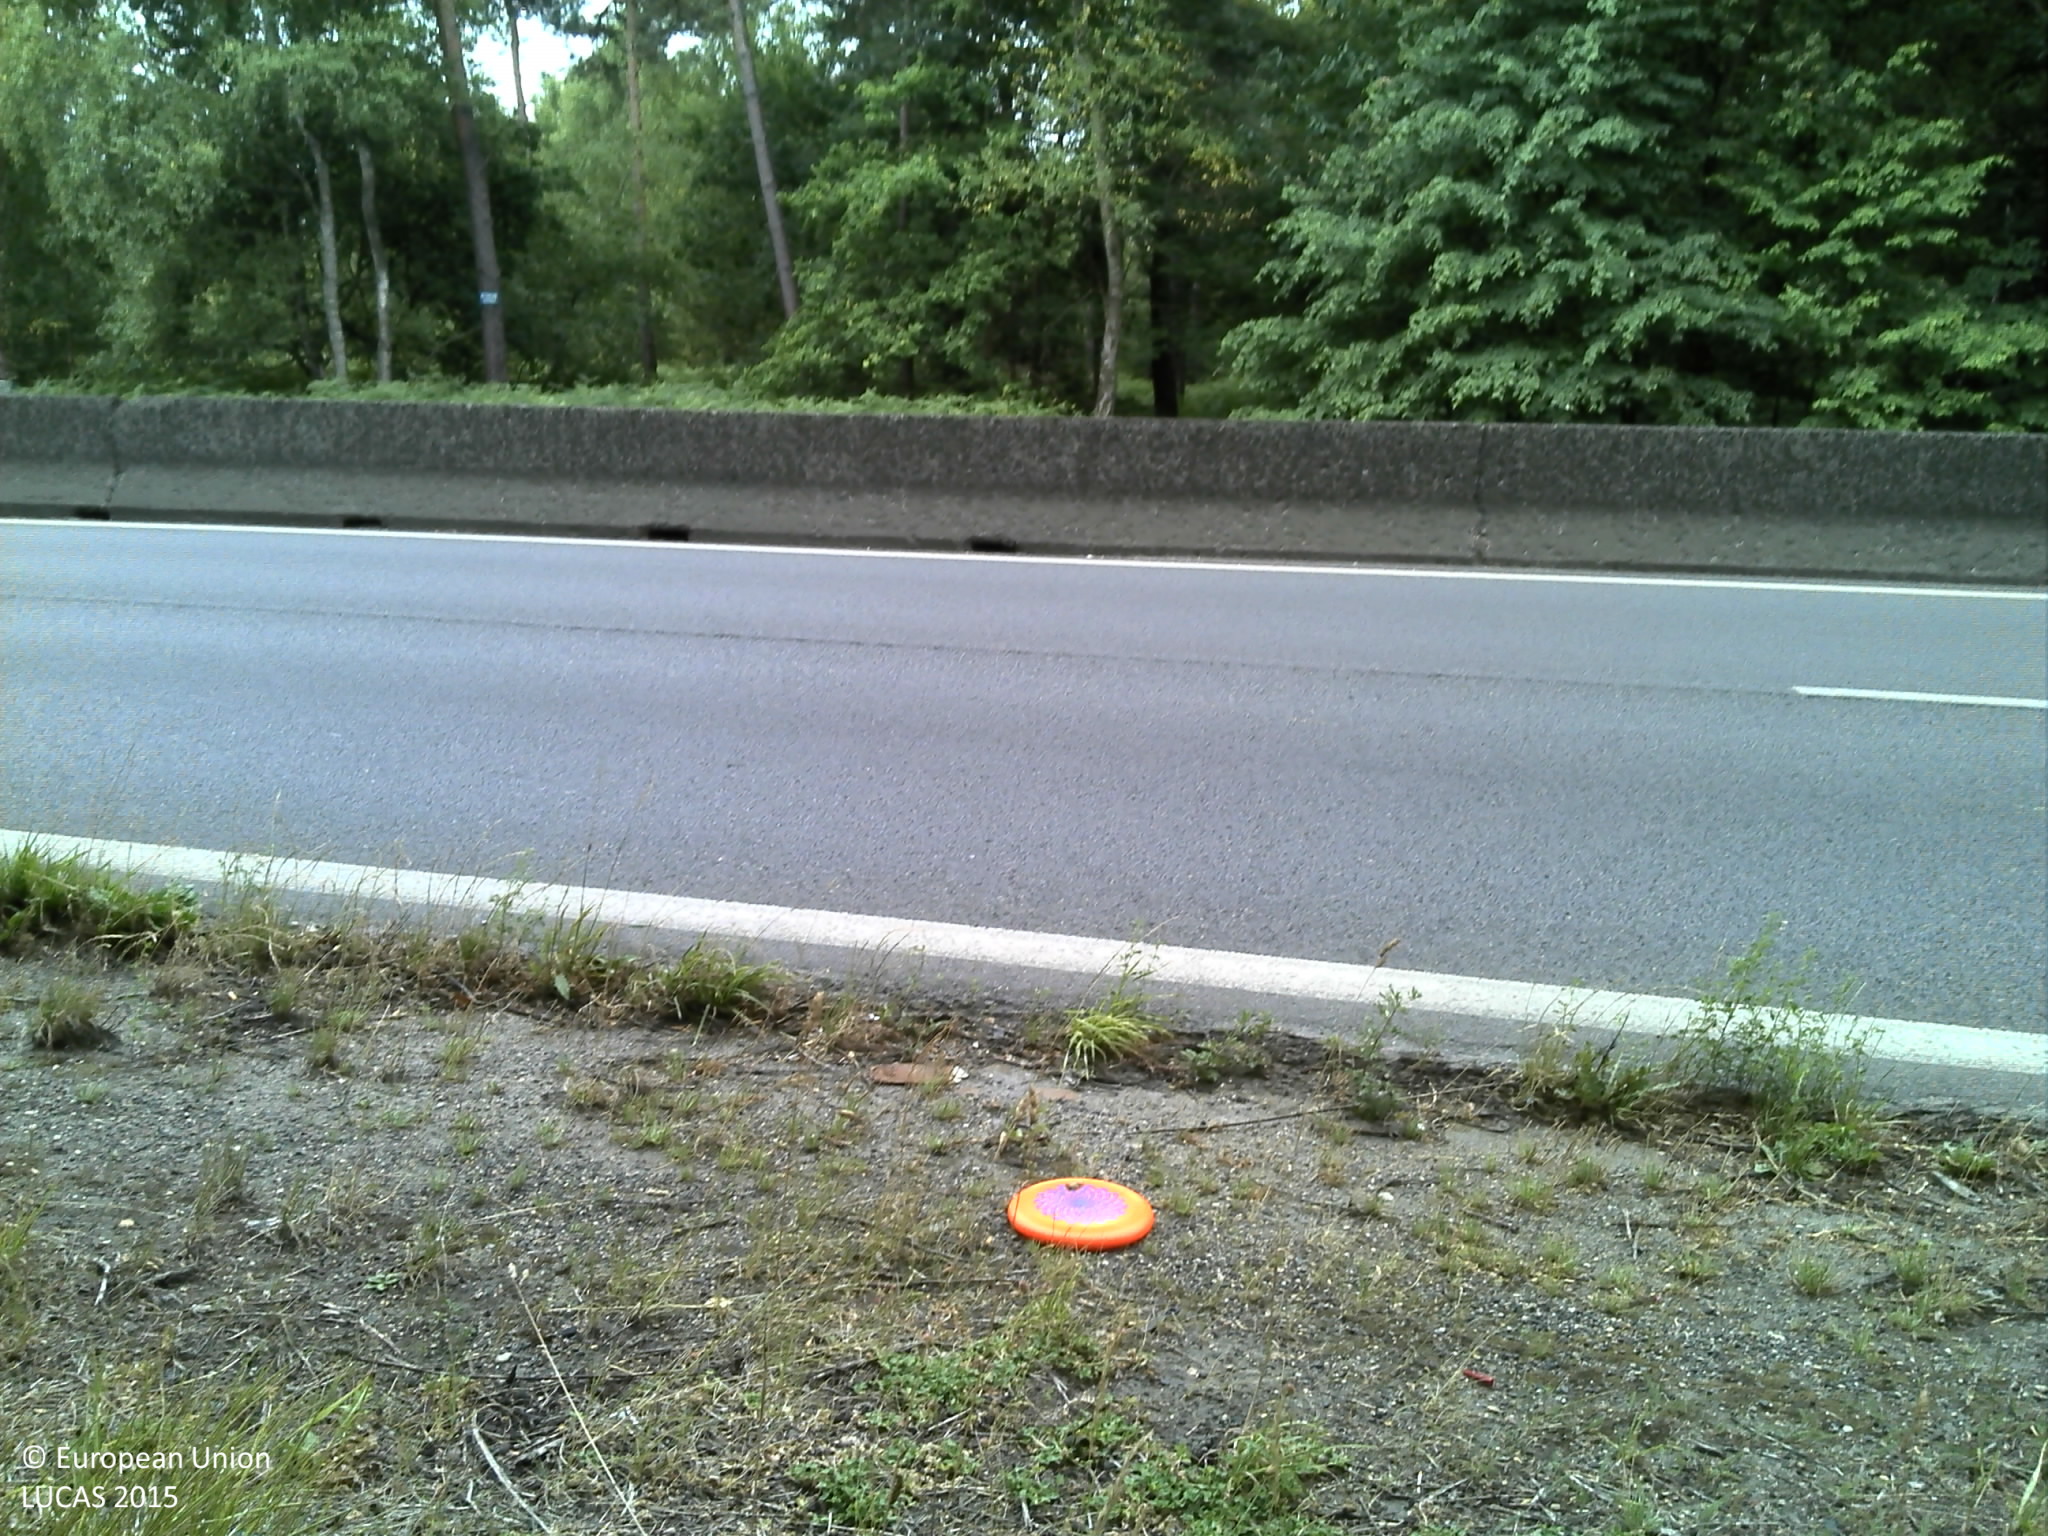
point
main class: Woodland
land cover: Pine dominated mixed woodland
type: hemiboreal forest and nemoral coniferous forest and mixed broadleaved-coniferous forest
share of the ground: > 75 %
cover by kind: broadleaved forest trees 55 %, coniferous forest trees 35 %, herbaceous plants 10 %
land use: Forestry
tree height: > 5 m
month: July
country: FR
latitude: 48.6891
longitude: 2.4768
